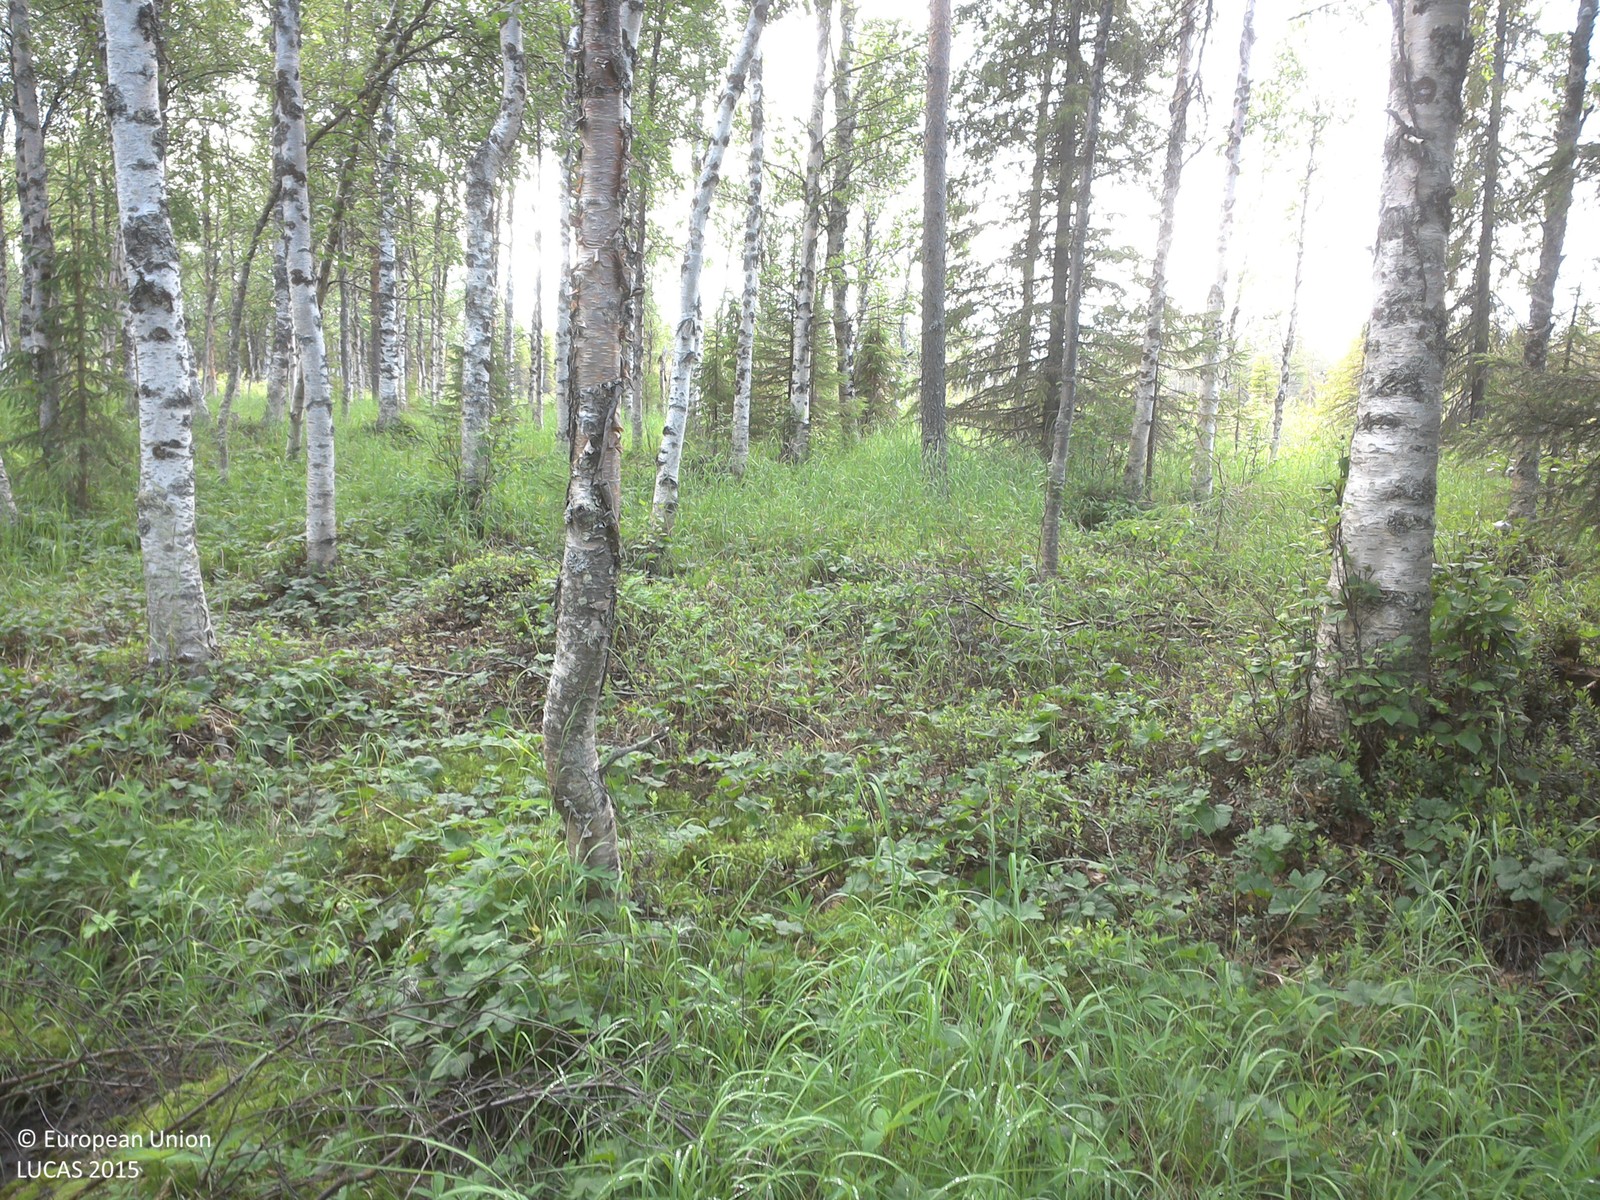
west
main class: Woodland
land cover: Other mixed woodland
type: boreal forest
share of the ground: 25 - 50 %
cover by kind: broadleaved forest trees 30 %, herbaceous plants 30 %, shrubs 15 %, lichens and mosses 15 %, coniferous forest trees 10 %
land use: Forestry
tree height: > 5 m
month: July
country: SE
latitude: 67.6510
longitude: 23.4699
